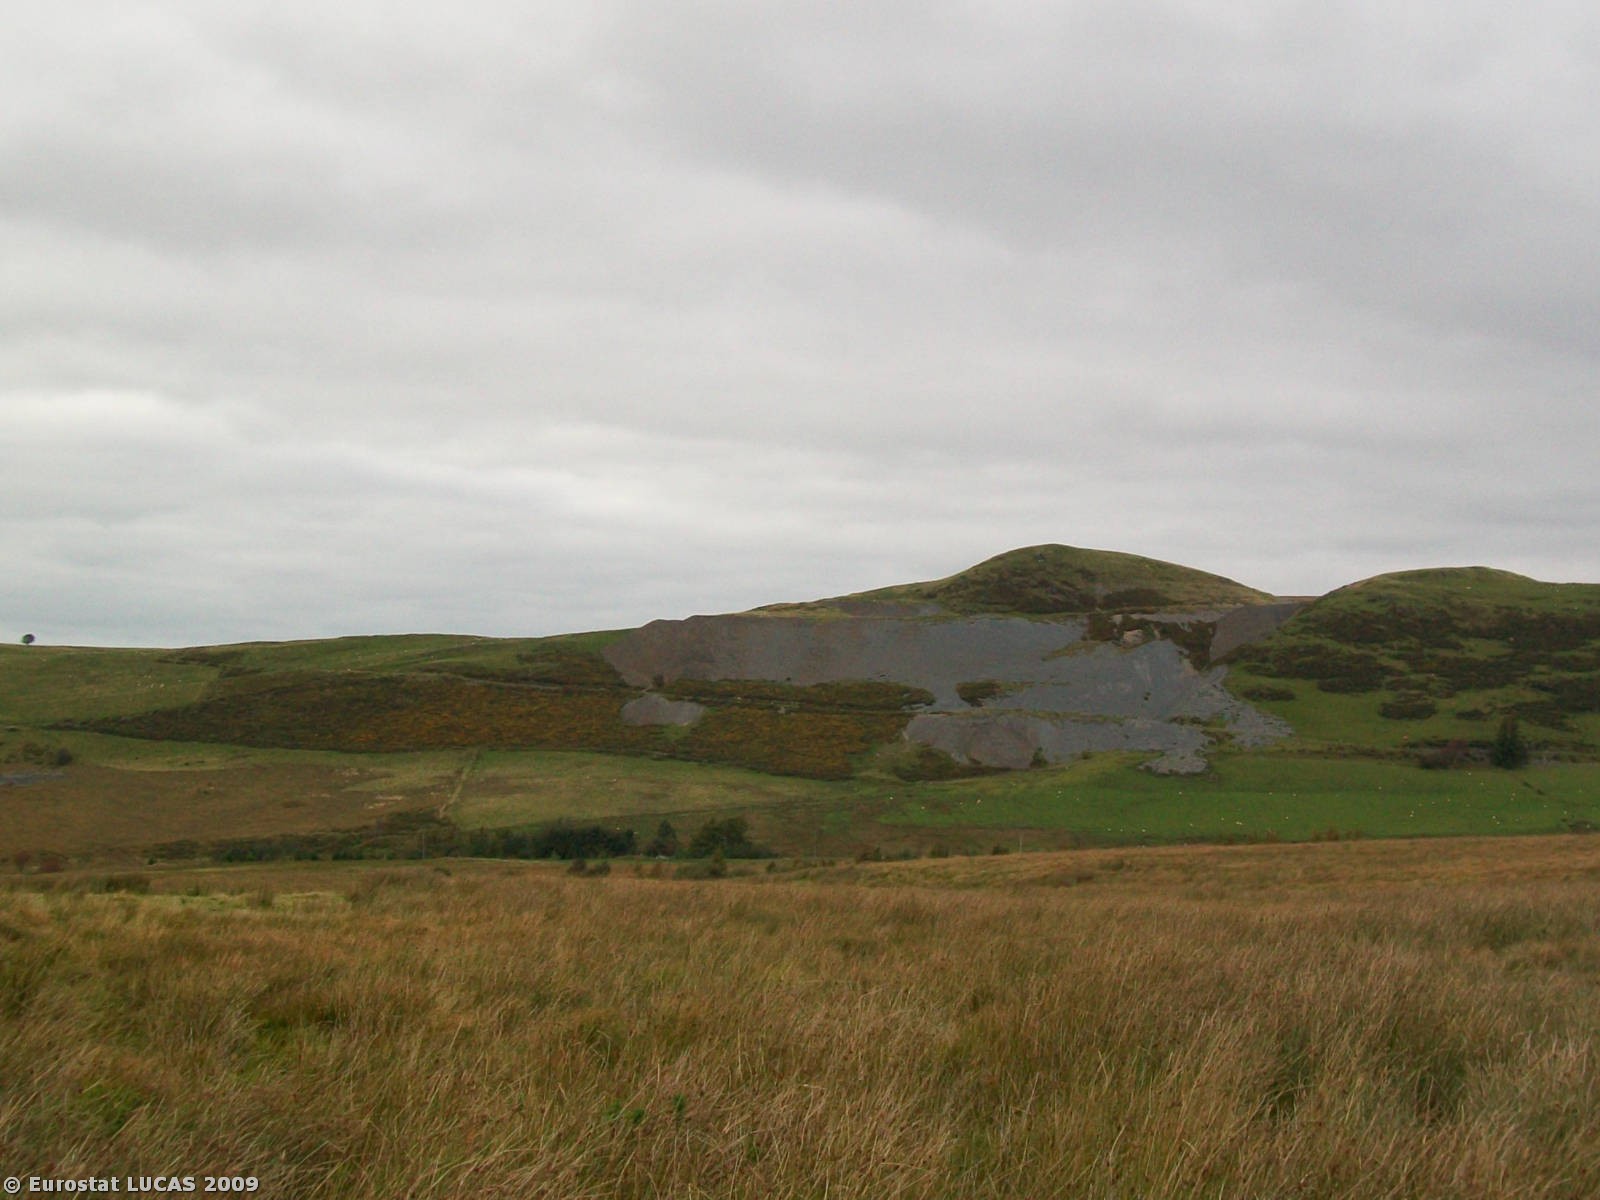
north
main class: Grassland
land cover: Grassland without tree/shrub cover
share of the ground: > 75 %
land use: Agriculture (excluding fallow land and kitchen gardens)
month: September
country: GB
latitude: 52.3105
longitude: -3.8348
